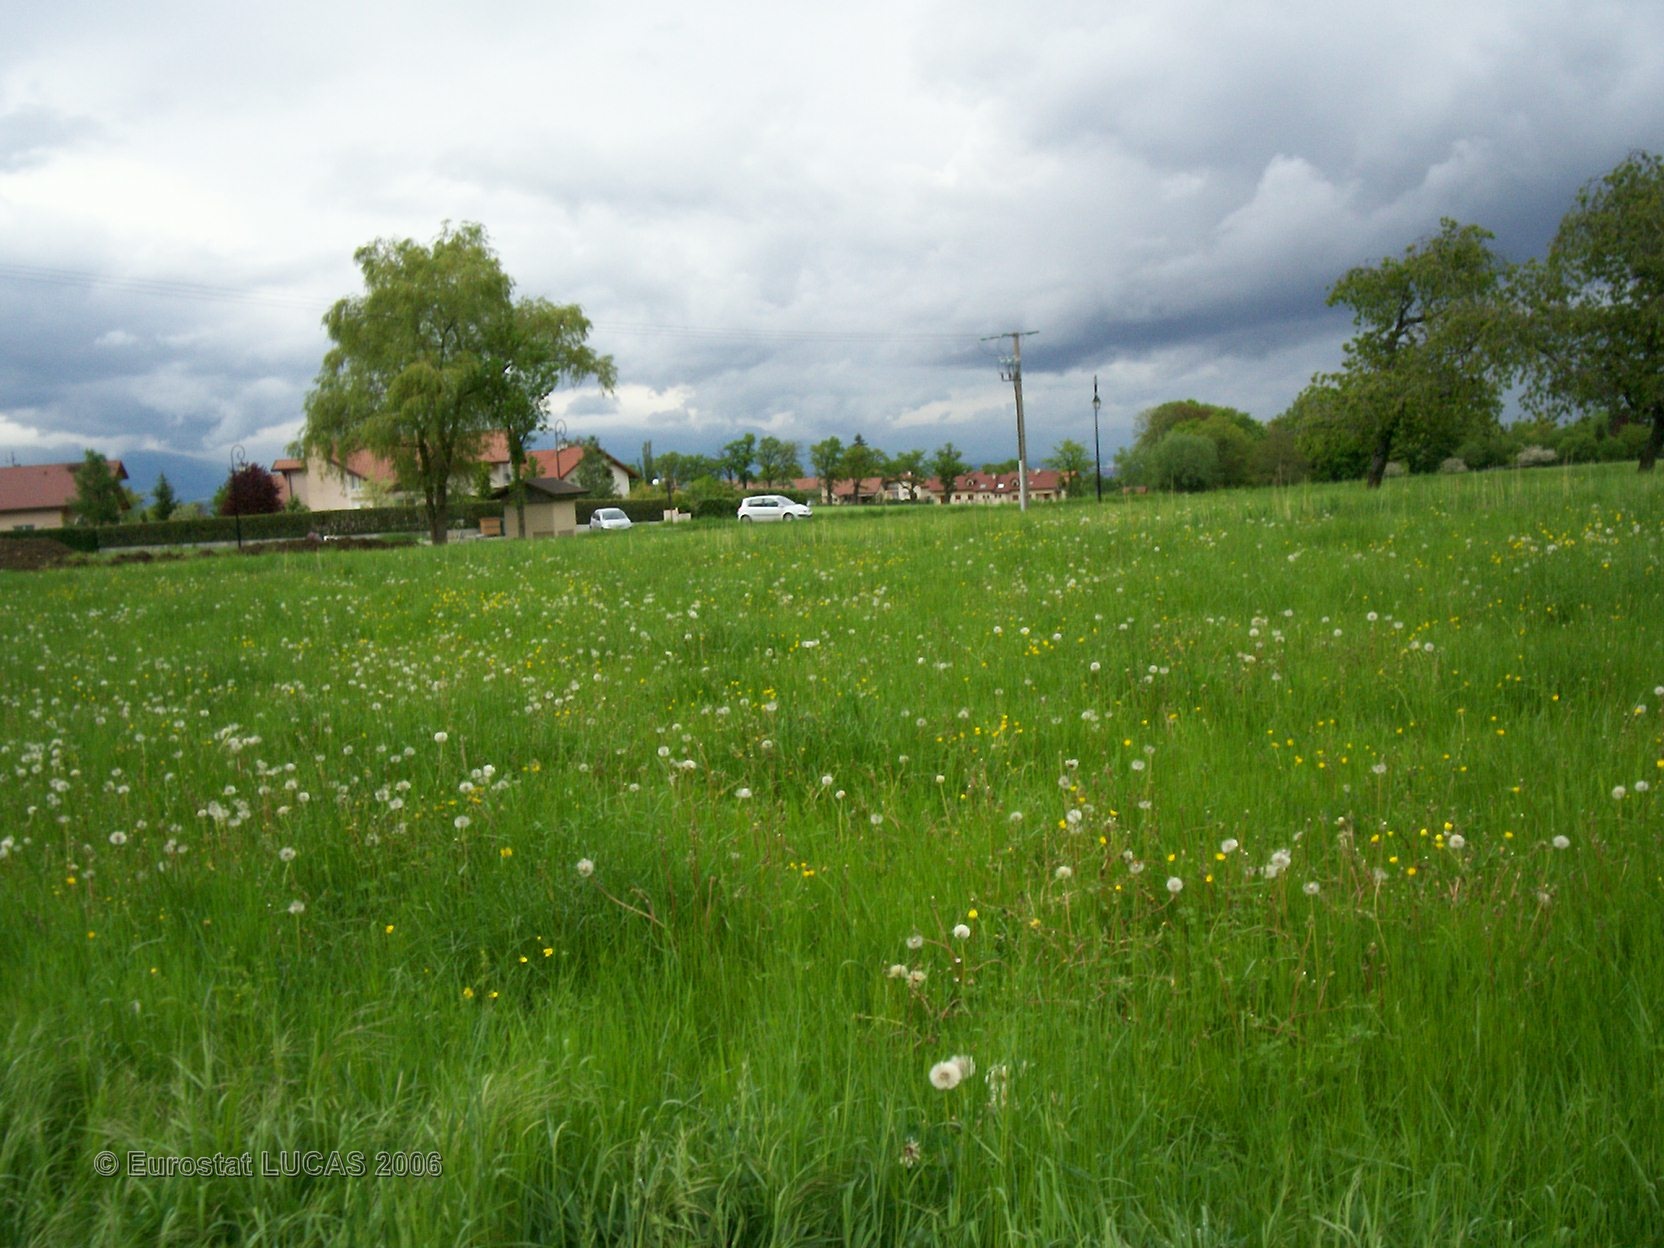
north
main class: Grassland
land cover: Grassland without tree/shrub cover
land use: Agriculture (excluding fallow land and kitchen gardens)
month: May
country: FR
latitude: 46.1181
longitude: 6.1087
